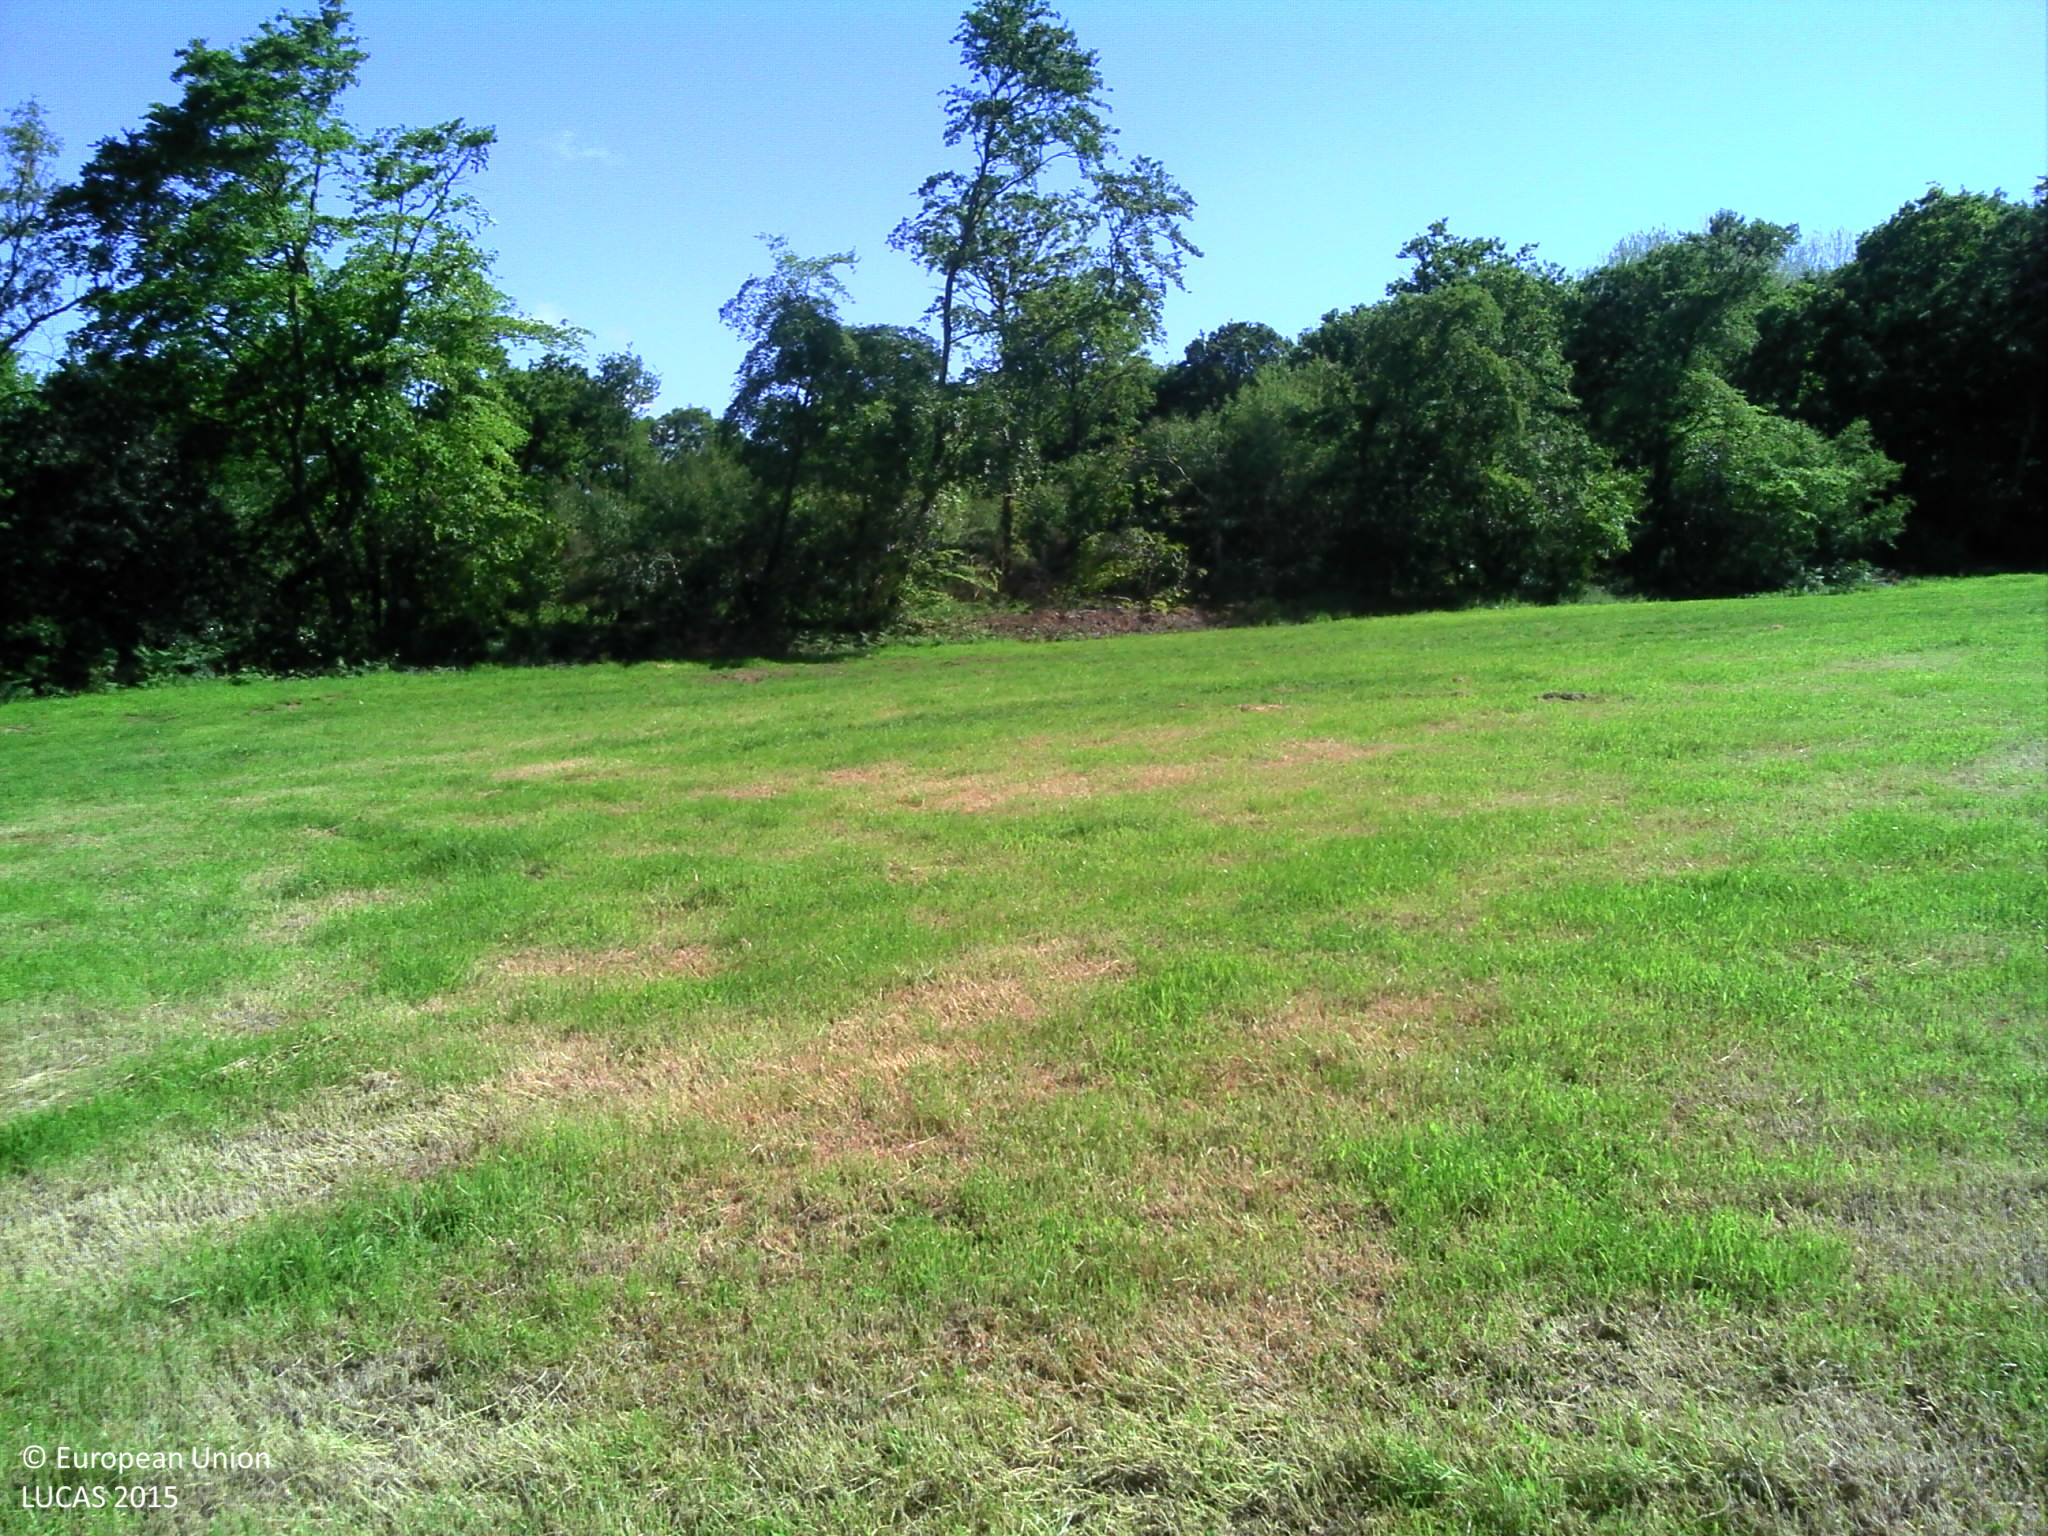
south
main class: Grassland
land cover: Grassland without tree/shrub cover
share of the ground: > 75 %
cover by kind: herbaceous plants 100 %
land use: Agriculture (excluding fallow land and kitchen gardens)
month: June
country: FR
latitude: 49.4691
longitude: -1.7127
